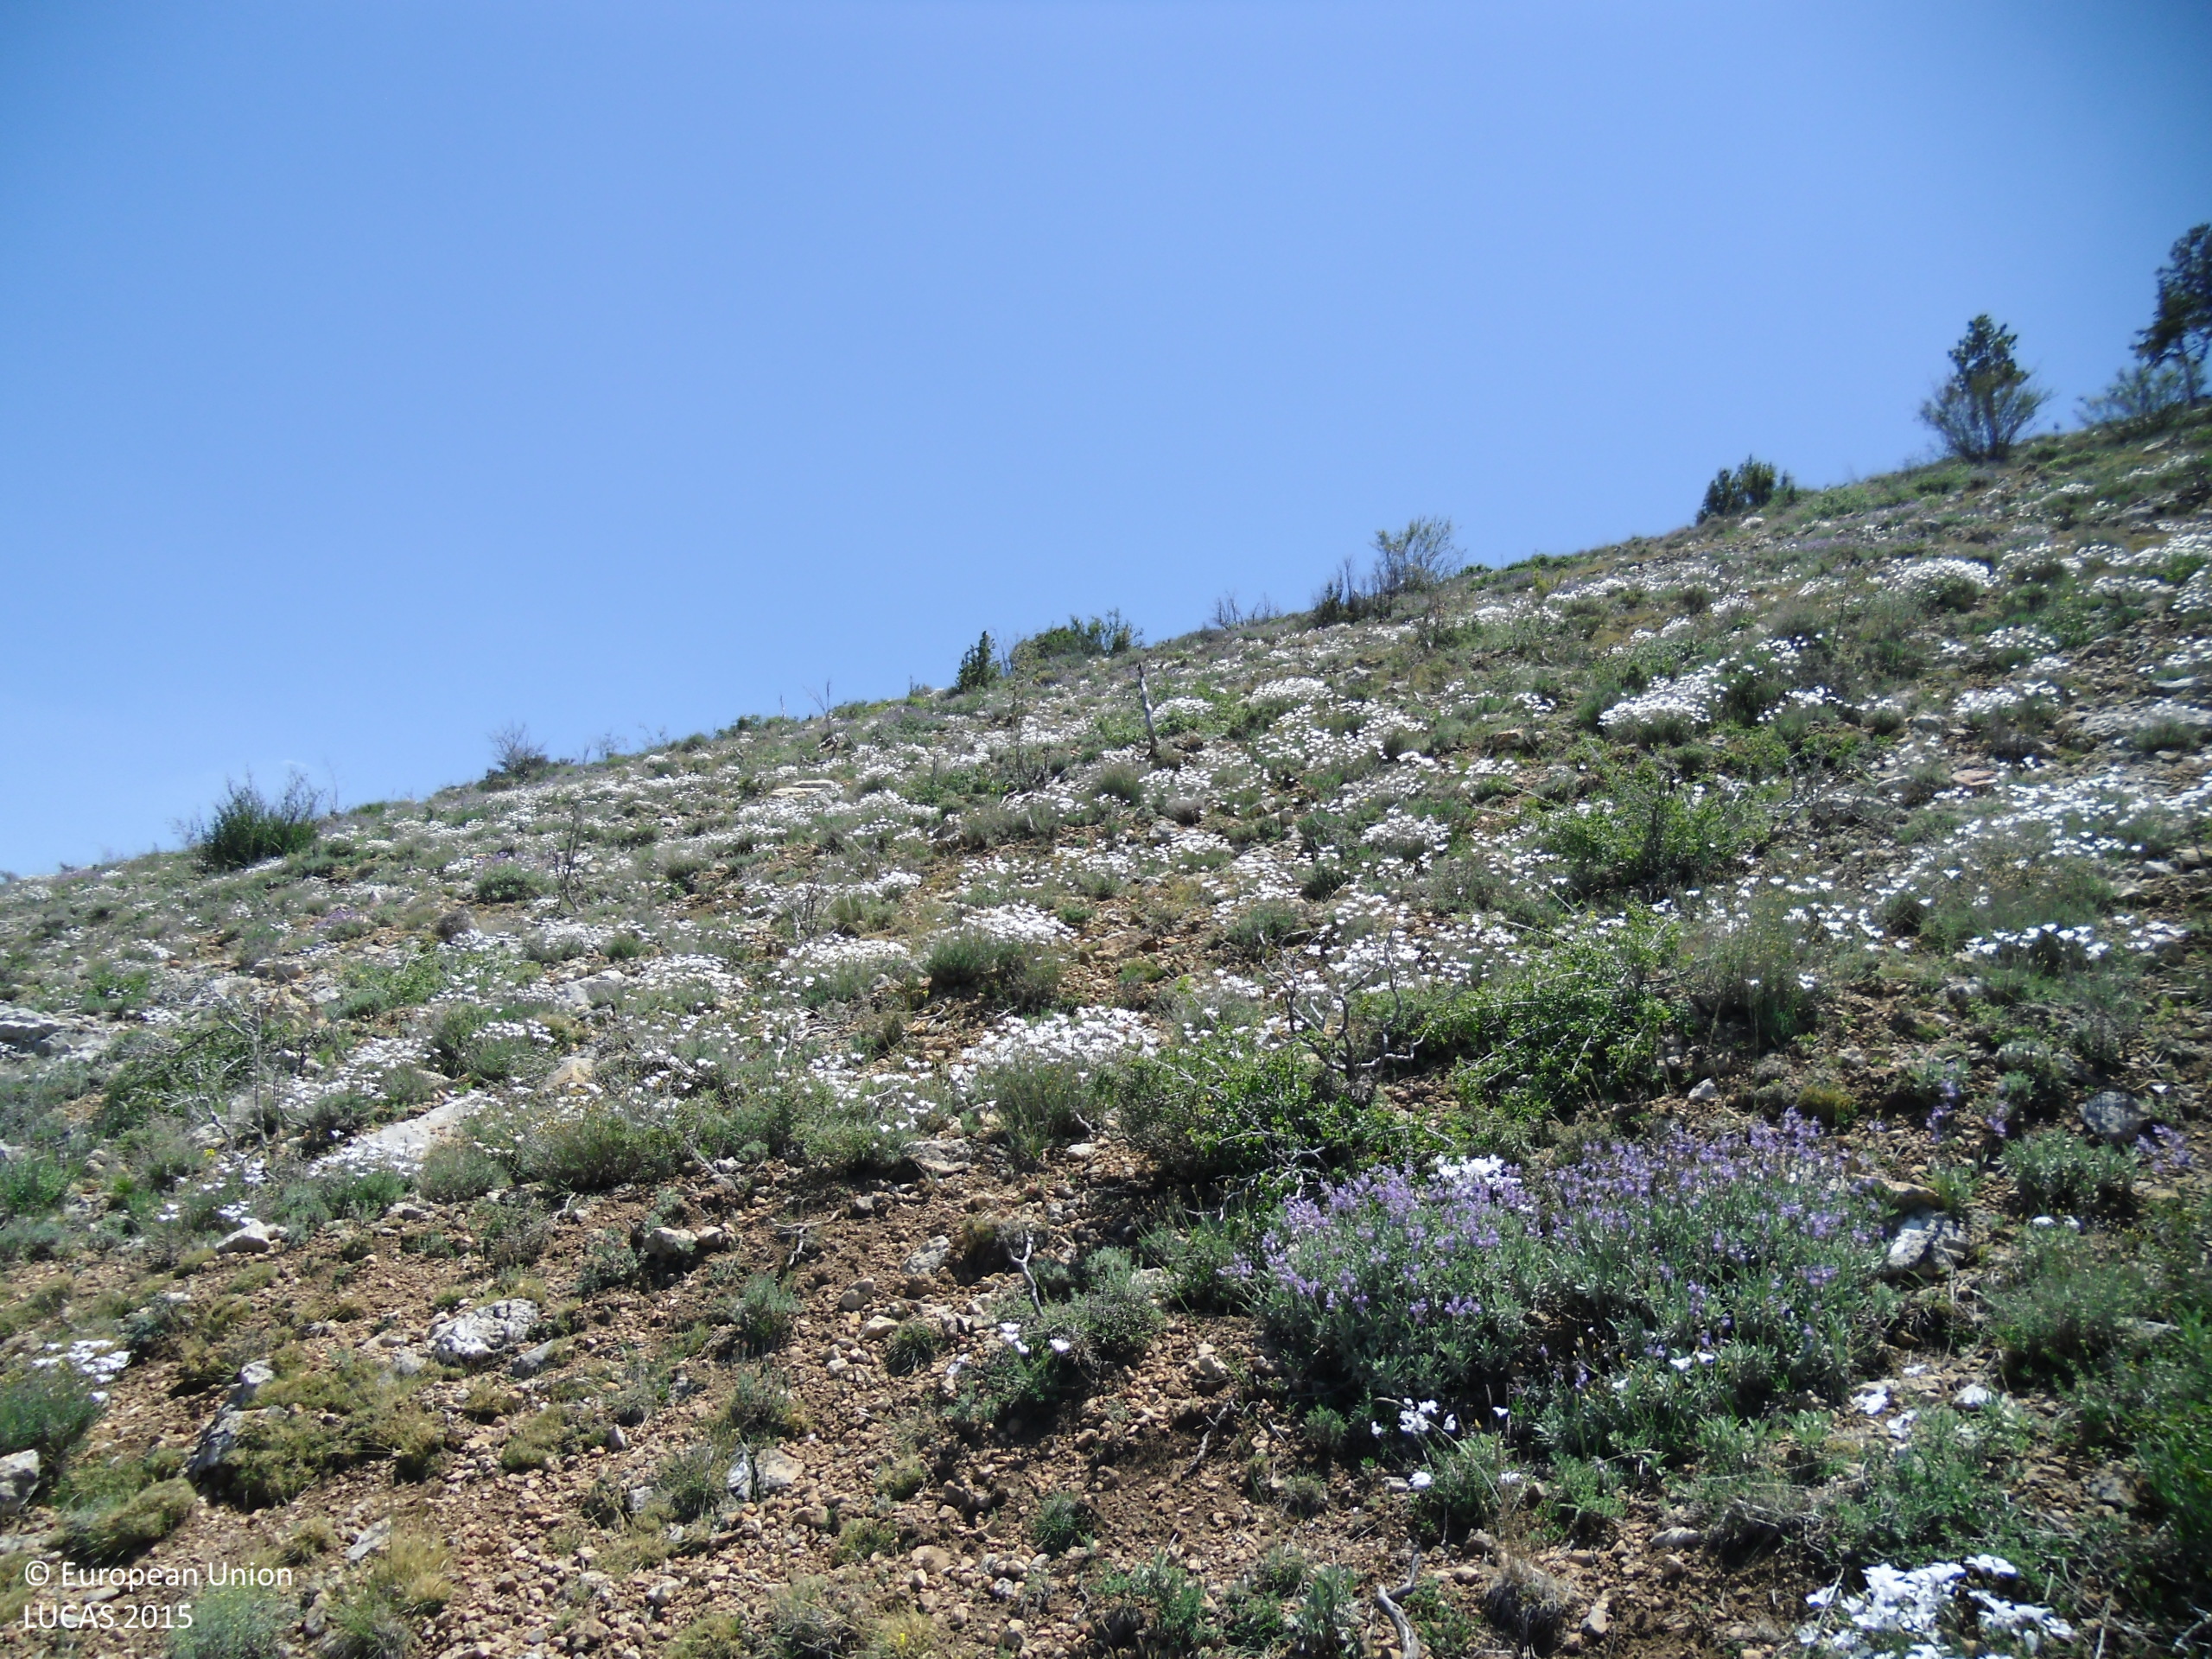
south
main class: Shrubland
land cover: Shrubland without tree cover
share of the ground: 10 - 25 %
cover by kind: consolidated bare surface 80 %, shrubs 15 %, herbaceous plants 5 %
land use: Semi-natural and natural areas not in use
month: June
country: ES
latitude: 40.7807
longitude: -0.6407
